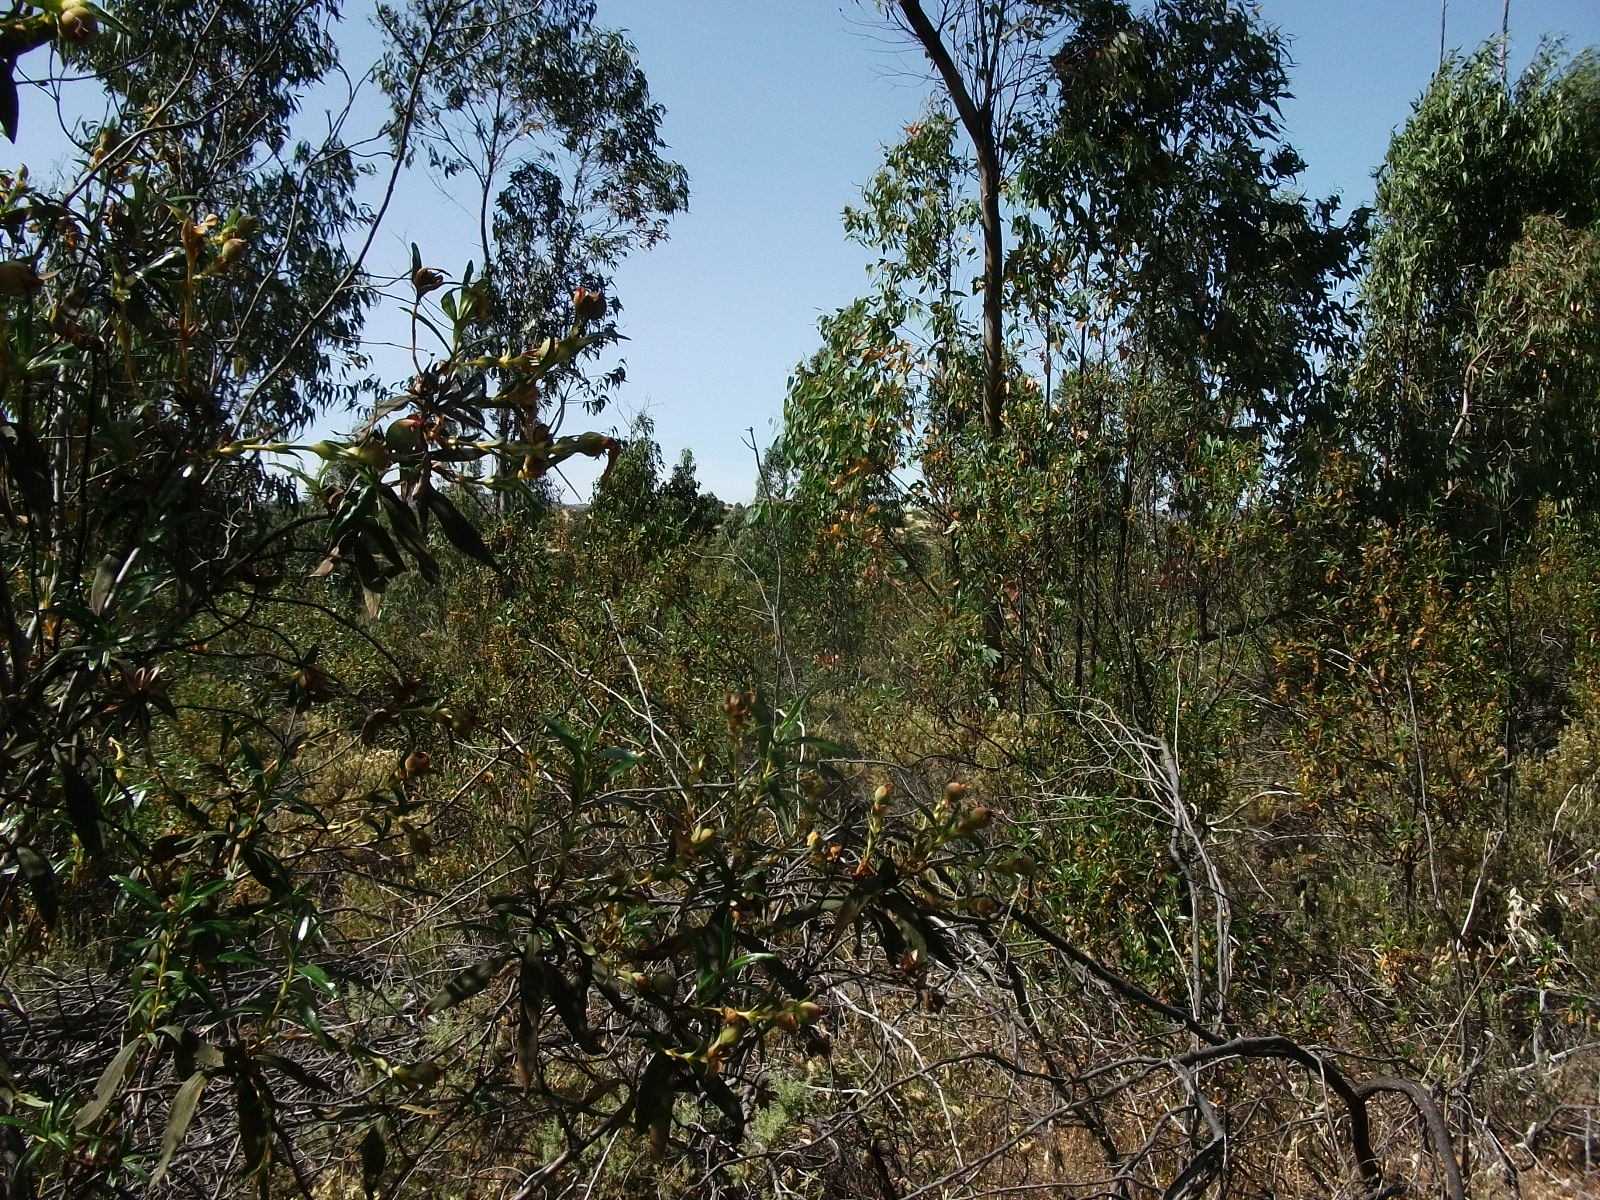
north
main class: Woodland
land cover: Broadleaved woodland
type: exotic forest
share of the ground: 25 - 50 %
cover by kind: shrubs 70 %, broadleaved forest trees 30 %
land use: Forestry
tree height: > 5 m
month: May
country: ES
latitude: 37.7426
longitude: -7.1773
